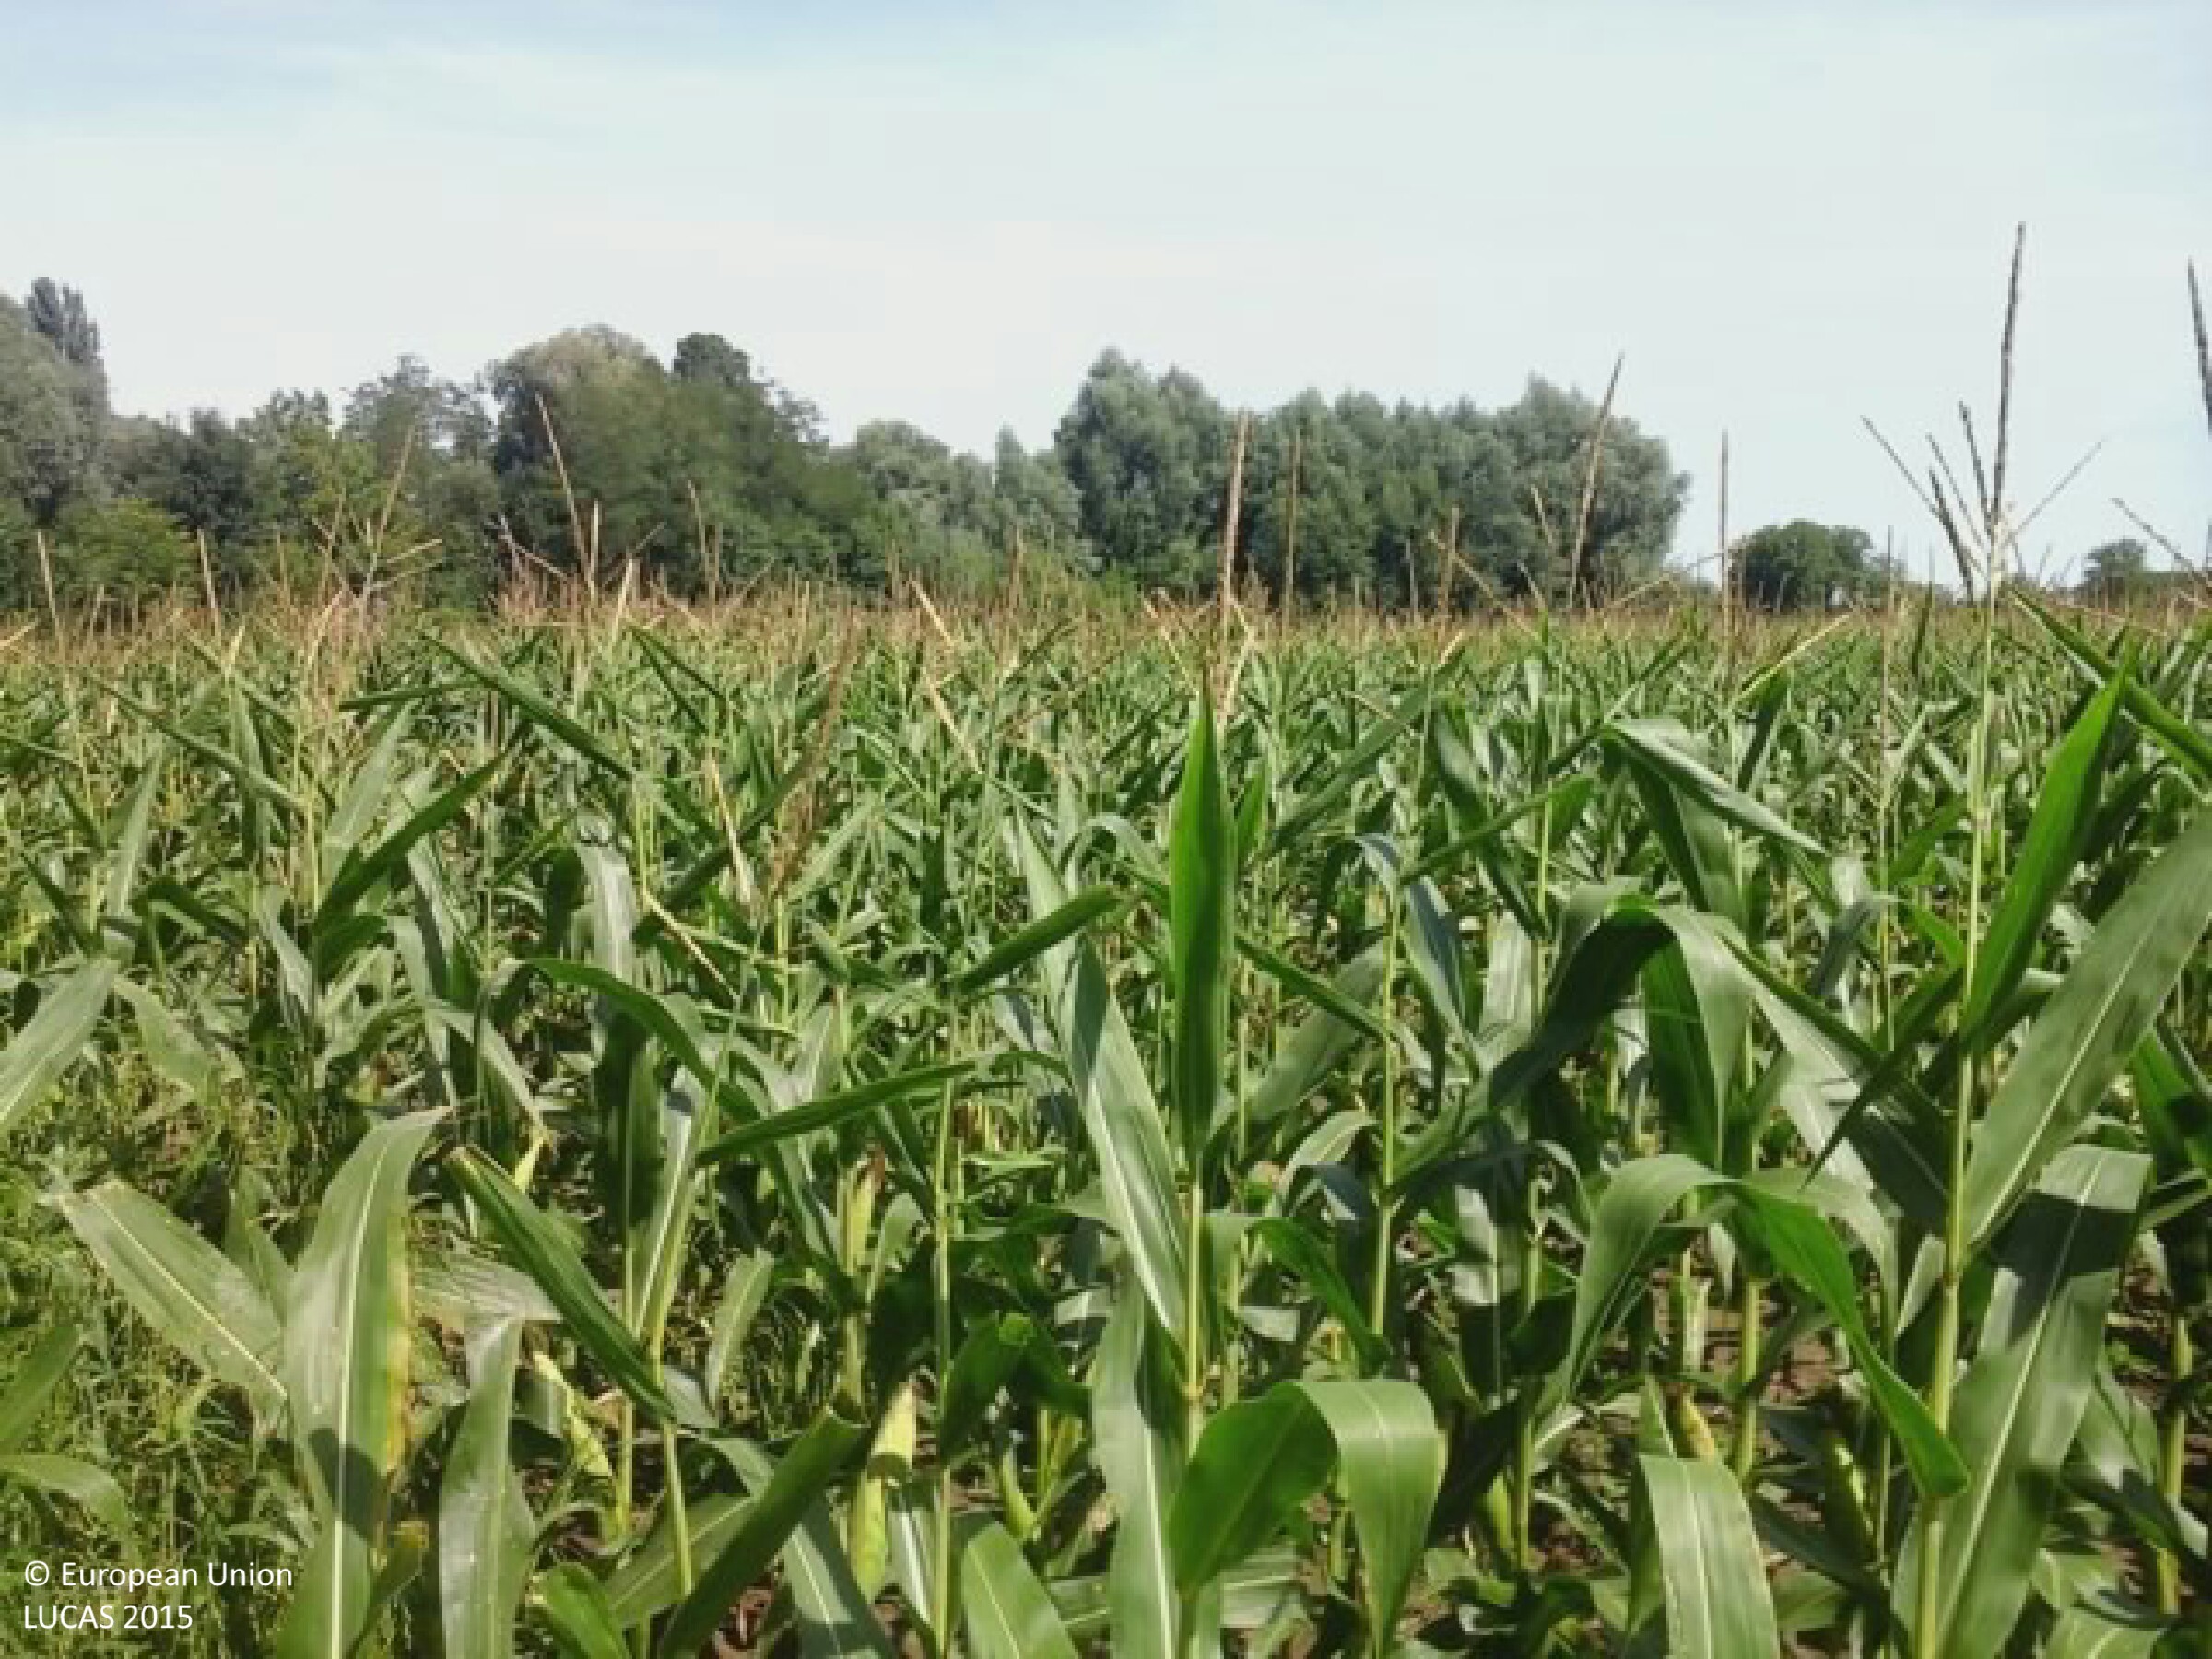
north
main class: Cropland
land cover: Sunflower
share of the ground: > 75 %
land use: Agriculture (excluding fallow land and kitchen gardens)
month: August
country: HU
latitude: 46.6364
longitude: 17.4117
